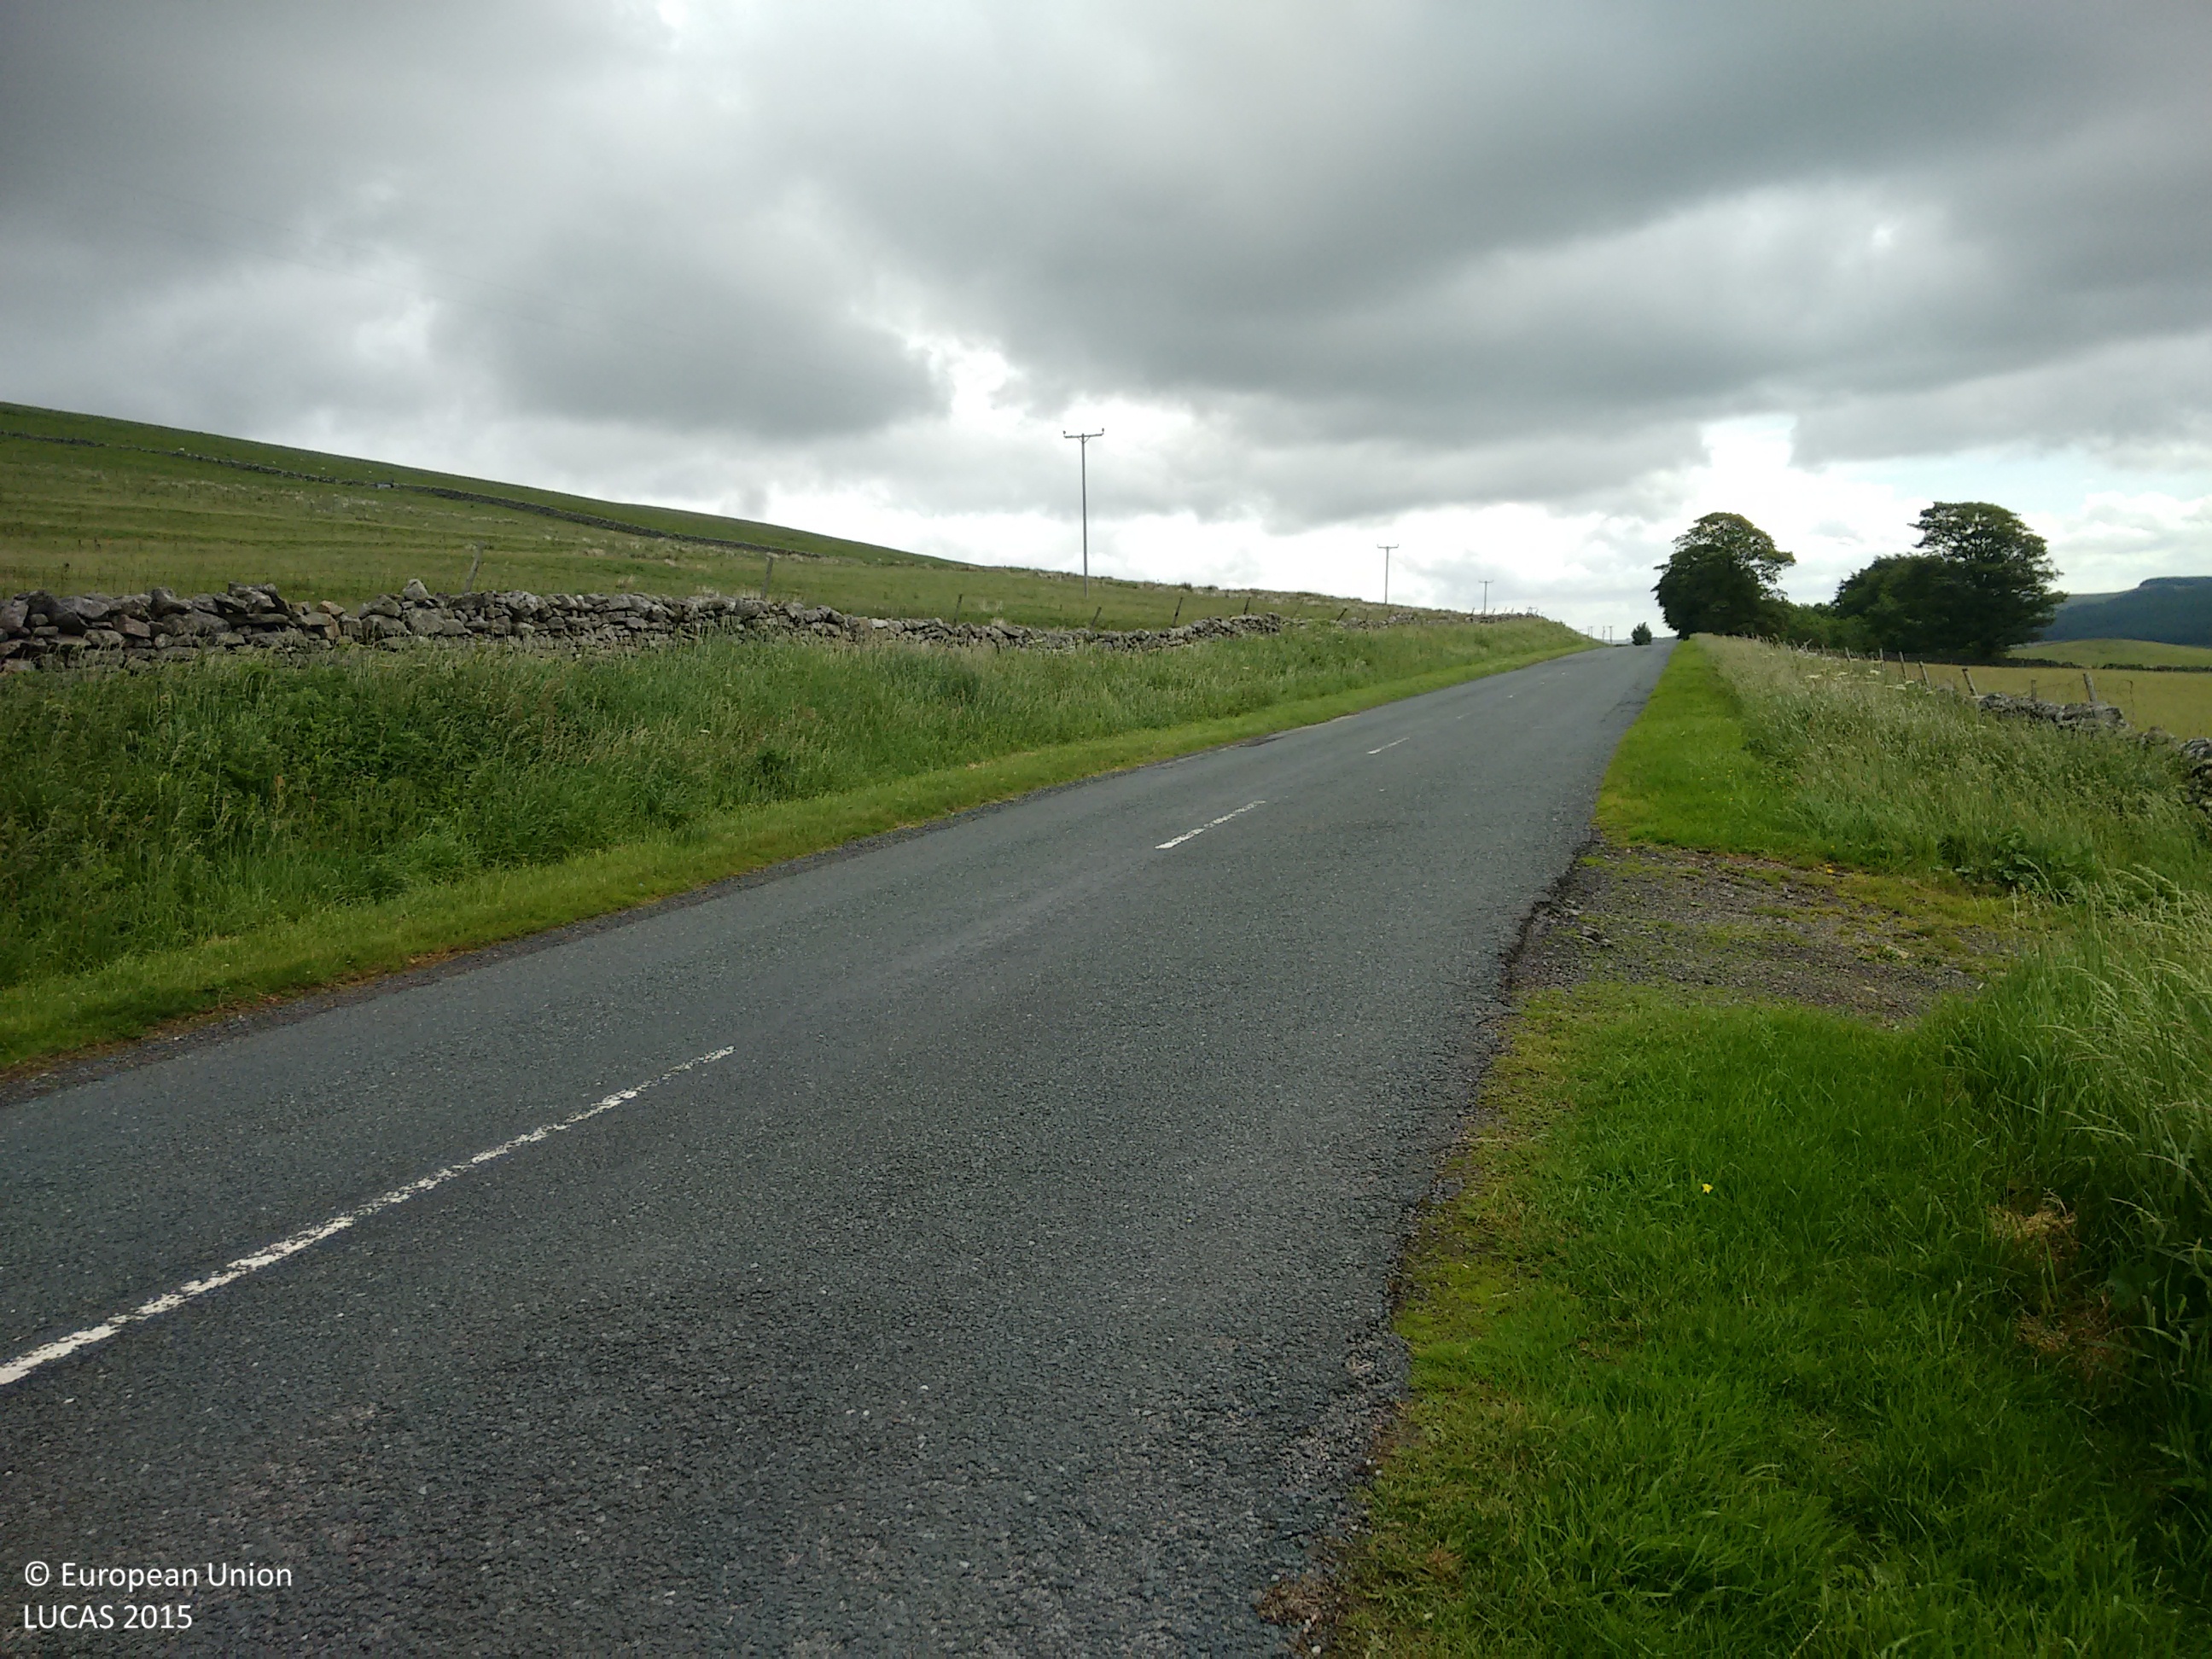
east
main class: Grassland
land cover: Grassland without tree/shrub cover
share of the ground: > 75 %
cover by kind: herbaceous plants 100 %
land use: Water supply and treatment
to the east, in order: Grassland without tree/shrub cover; Dry stone walls; Grassland without tree/shrub cover; Dry stone walls; Grassland without tree/shrub cover
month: July
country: GB
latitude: 54.5892
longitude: -2.1439
